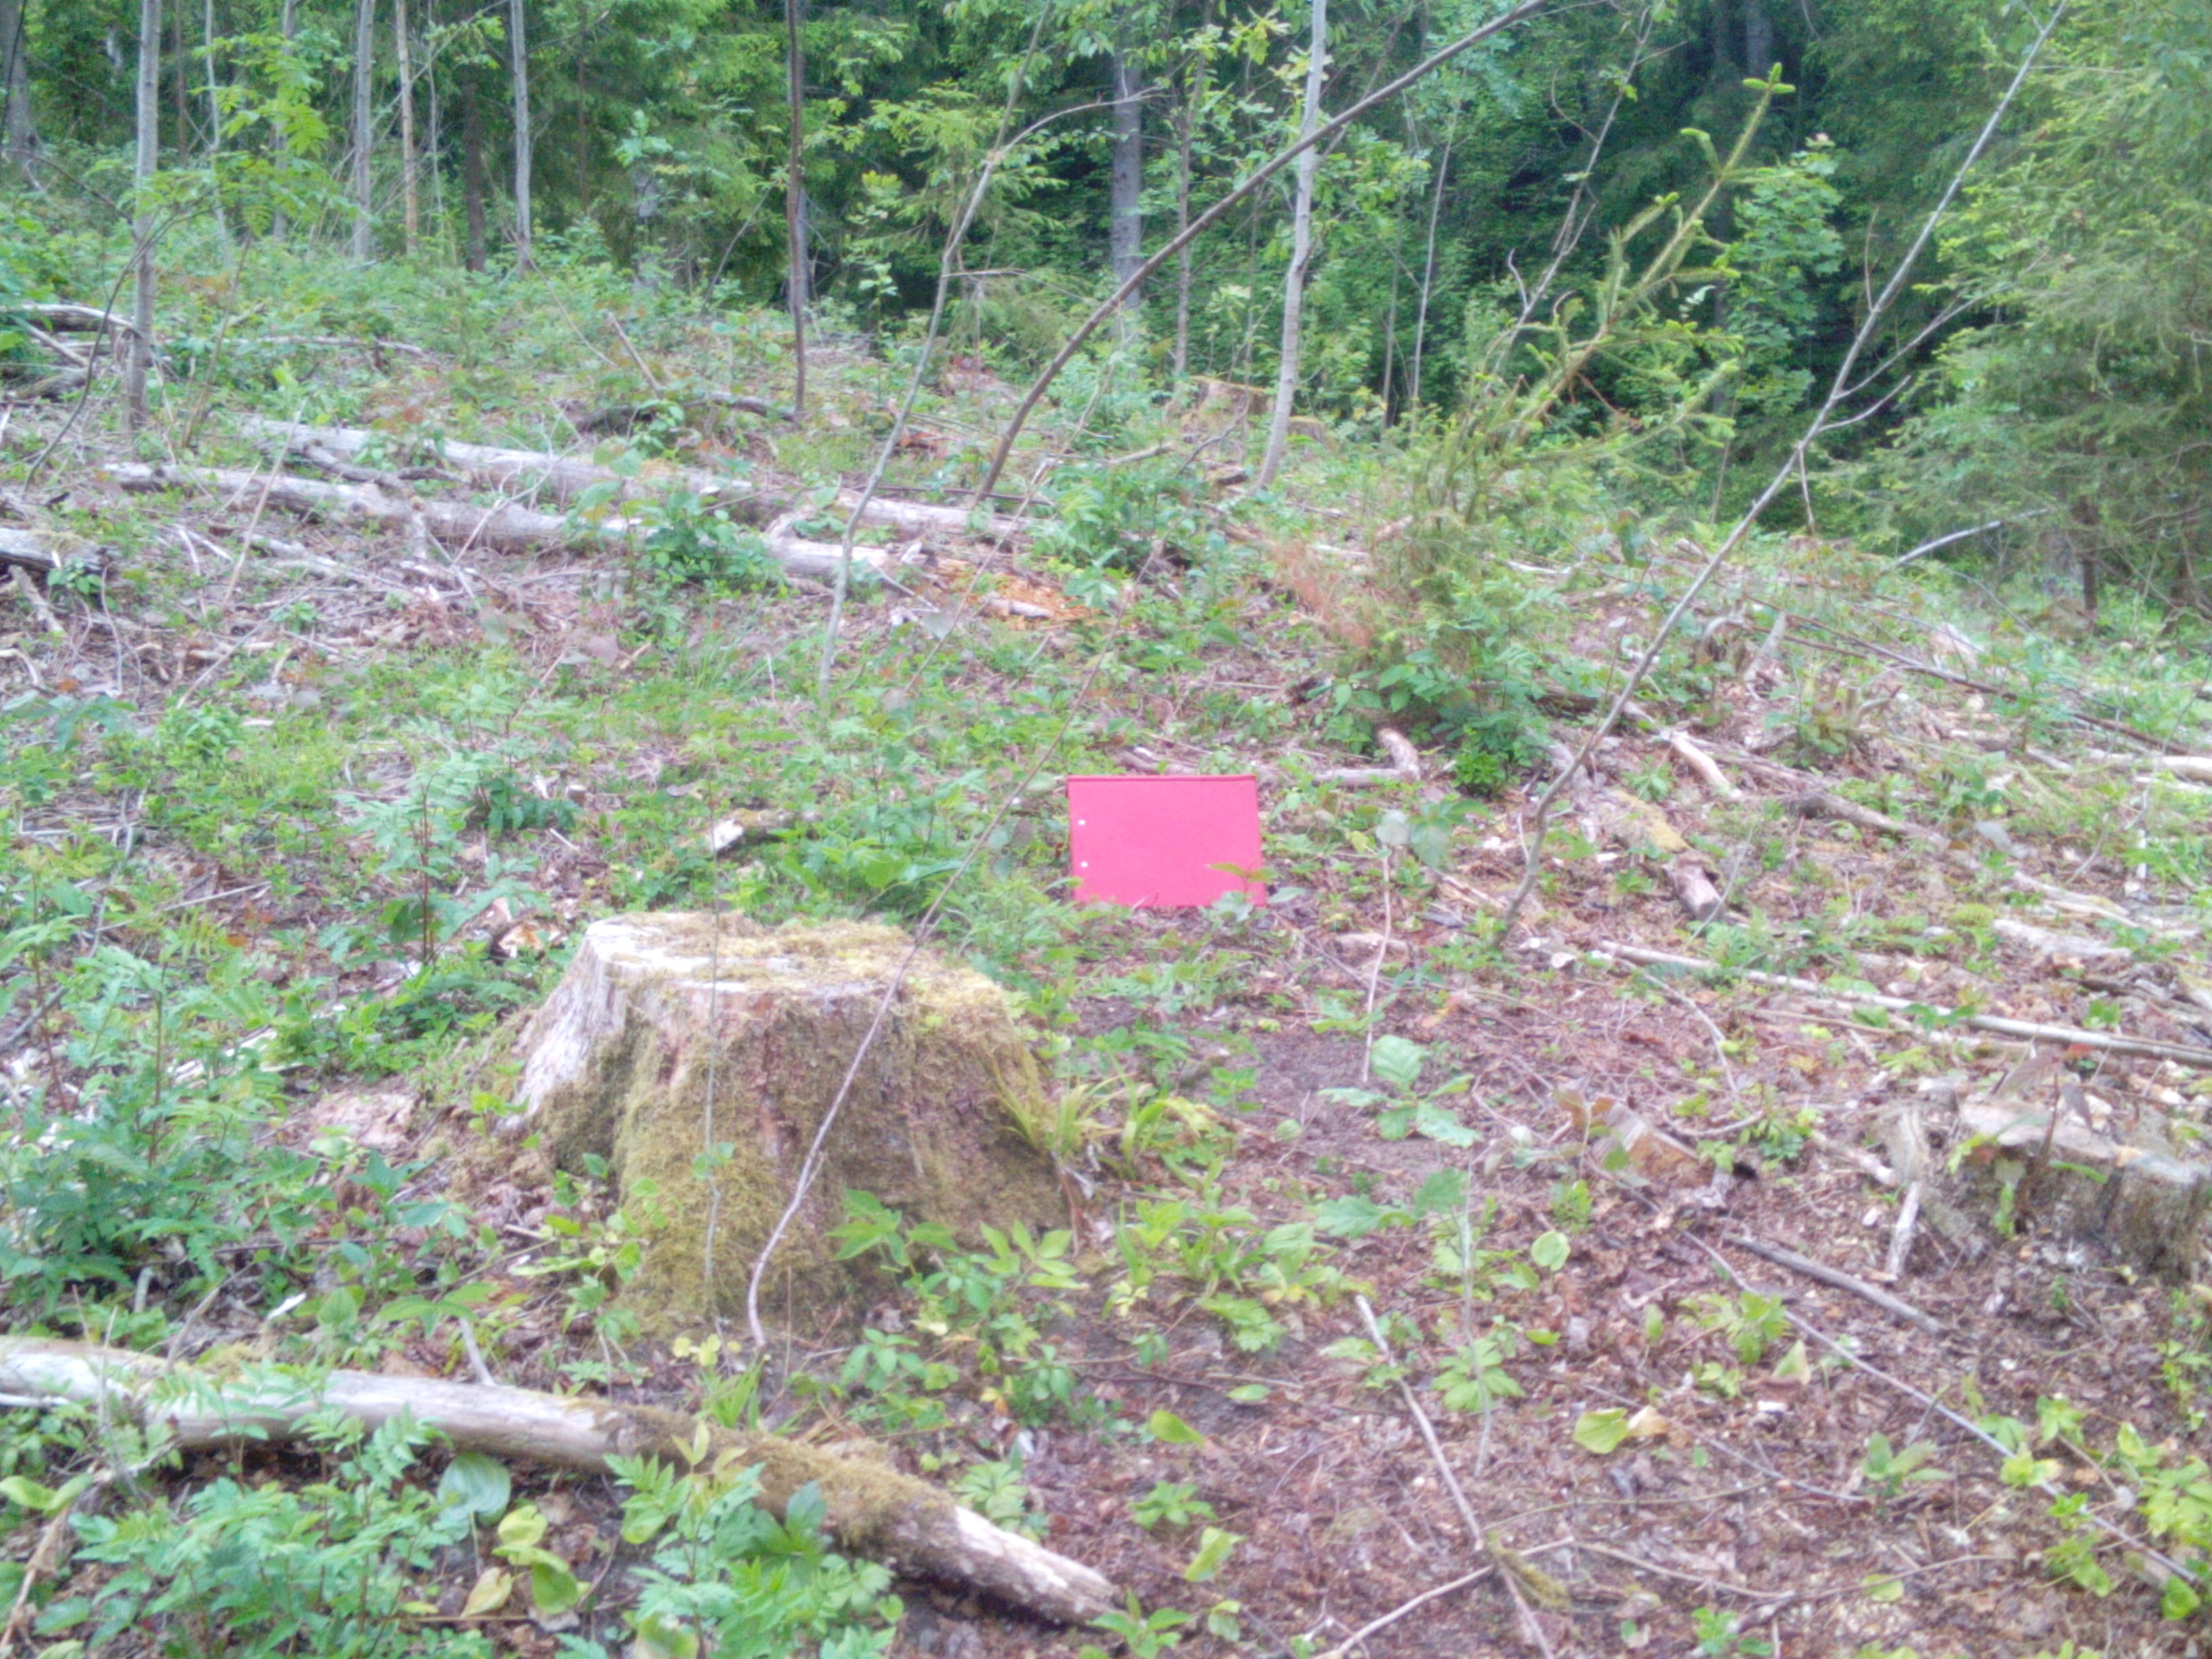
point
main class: Woodland
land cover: Spruce dominated mixed woodland
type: hemiboreal forest and nemoral coniferous forest and mixed broadleaved-coniferous forest
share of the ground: 25 - 50 %
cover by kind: herbaceous plants 35 %, coniferous forest trees 25 %, broadleaved forest trees 20 %, shrubs 15 %
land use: Forestry
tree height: > 5 m
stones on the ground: 10 - 25 %
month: June
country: LV
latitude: 56.8509
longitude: 21.9016
